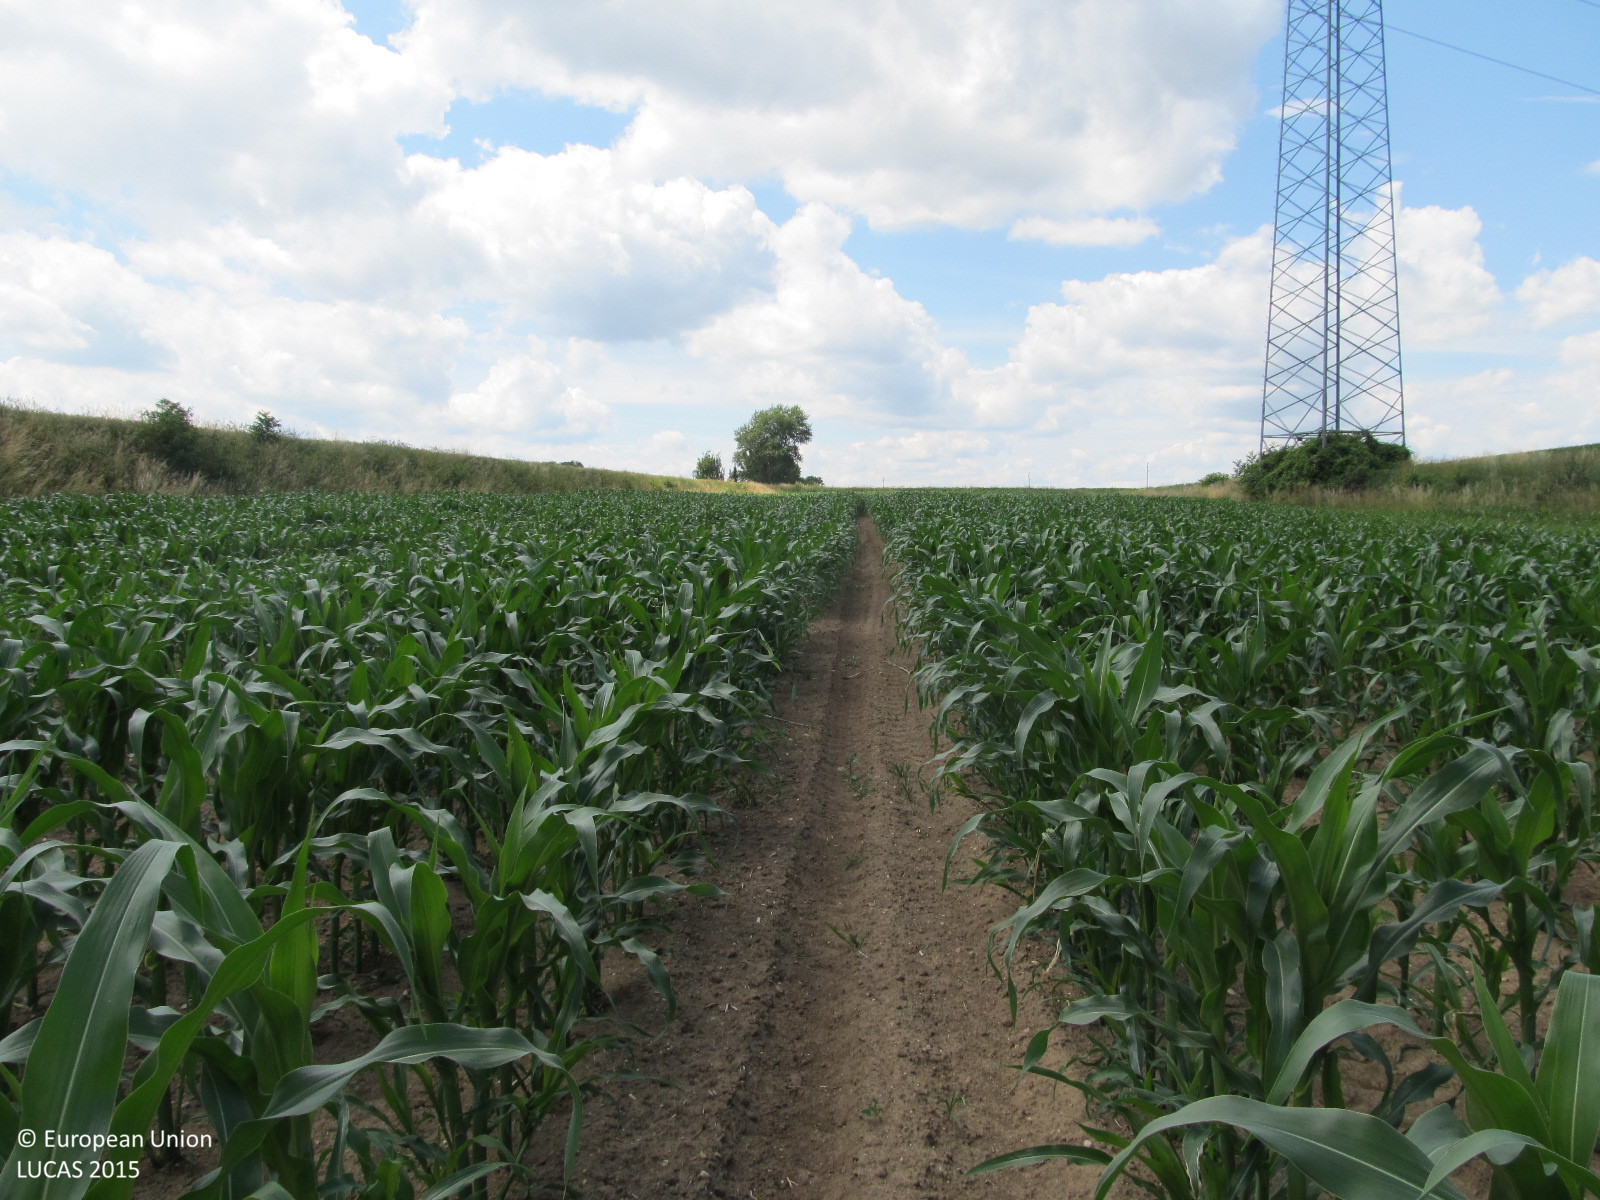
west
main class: Cropland
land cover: Maize
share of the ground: 50 - 75 %
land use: Agriculture (excluding fallow land and kitchen gardens)
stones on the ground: < 10 %
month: June
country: AT
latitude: 48.5184
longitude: 15.8660
